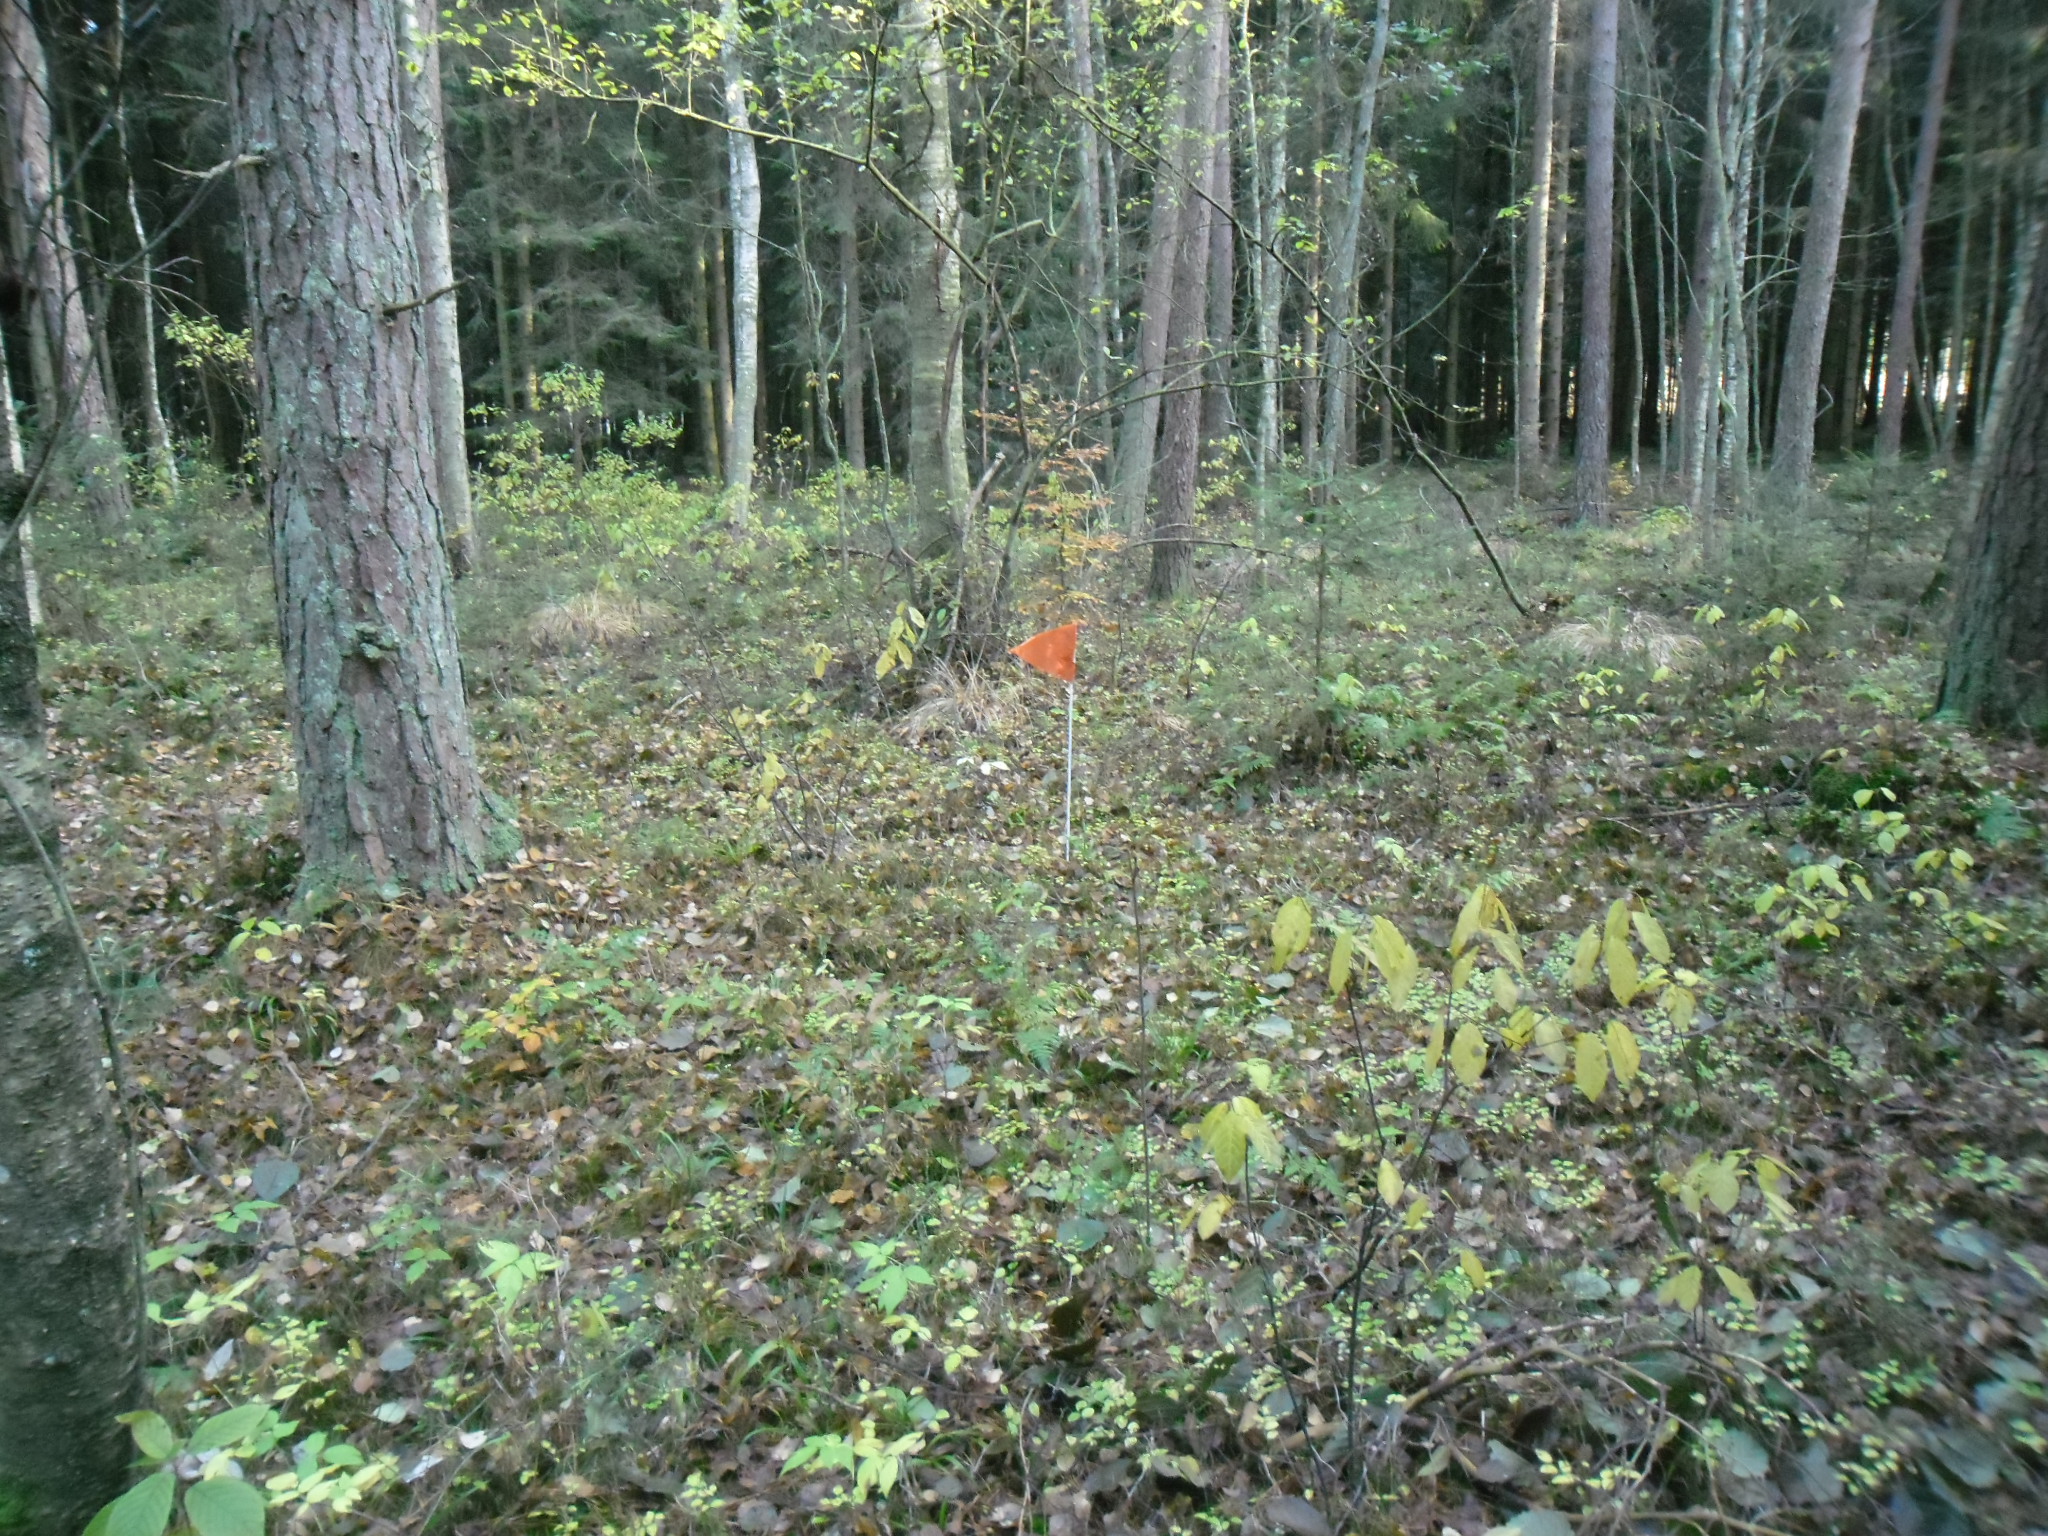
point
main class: Woodland
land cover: Pine dominated mixed woodland
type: boreal forest
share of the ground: > 75 %
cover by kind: coniferous forest trees 50 %, broadleaved forest trees 25 %, herbaceous plants 25 %
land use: Forestry
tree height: > 5 m
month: October
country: SE
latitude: 56.3103
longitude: 13.1817
